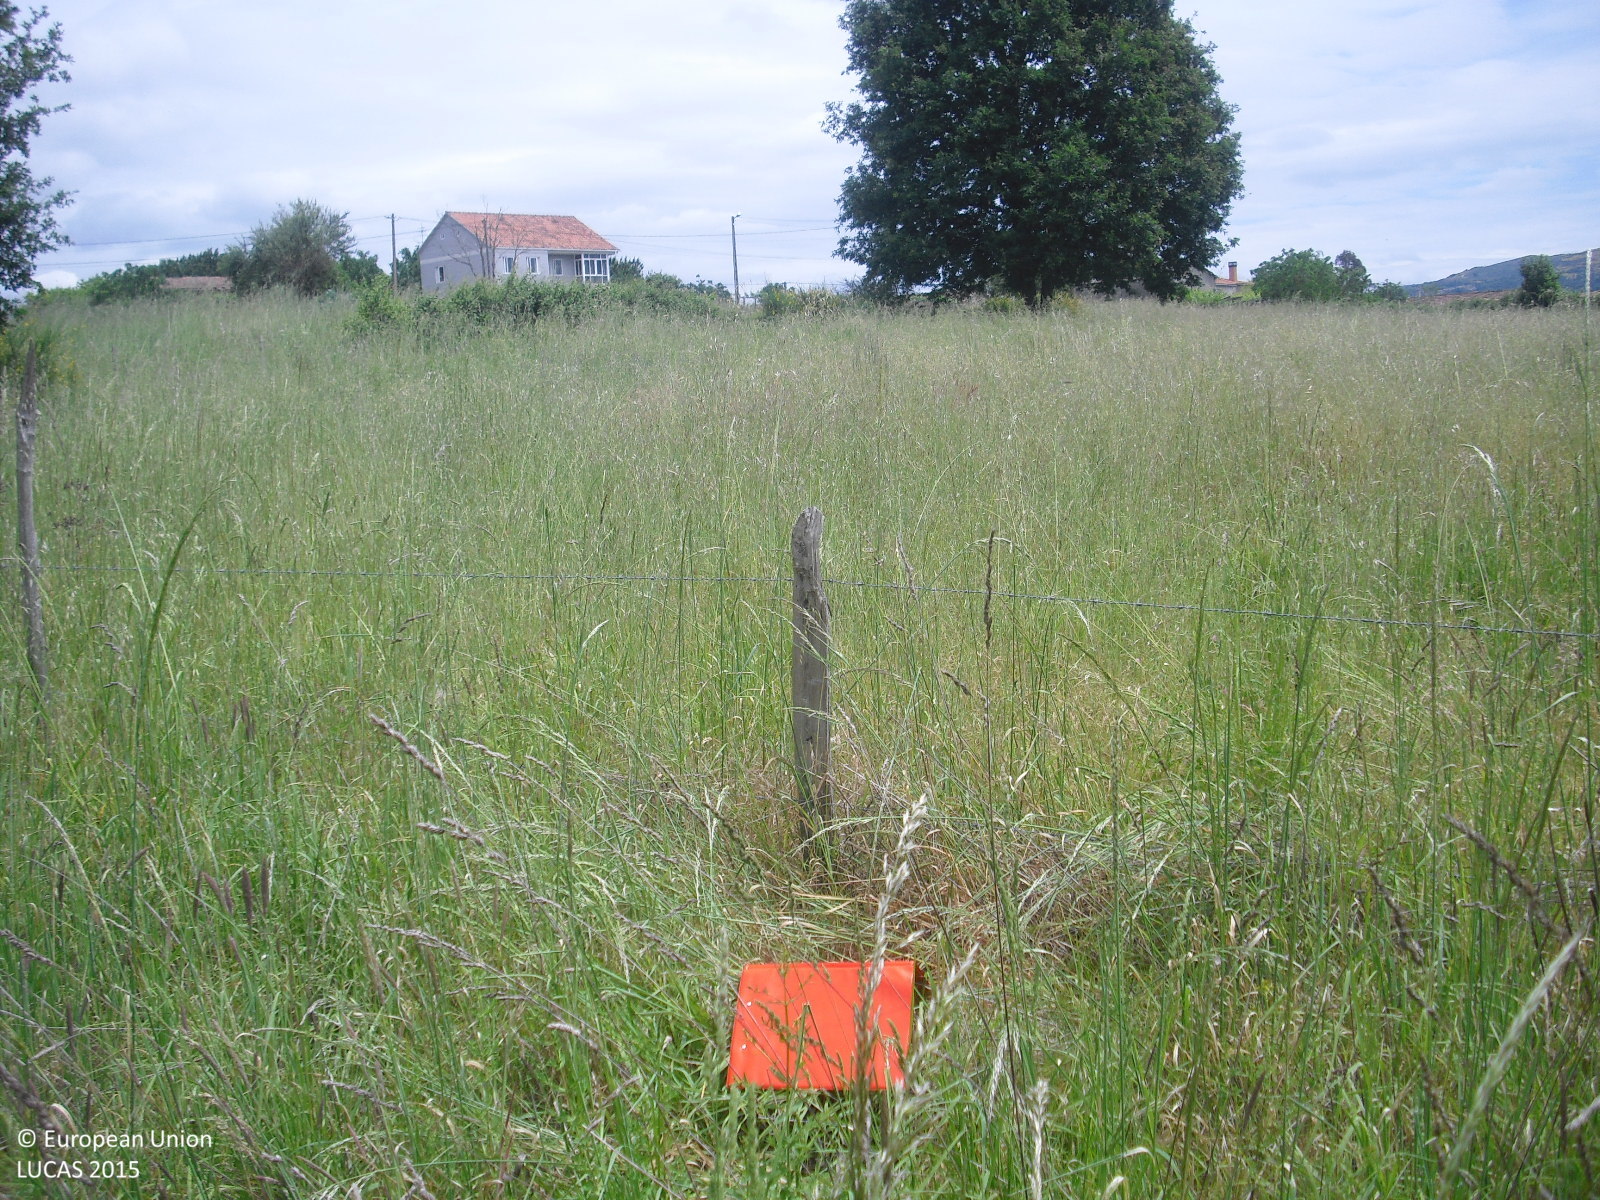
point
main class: Grassland
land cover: Grassland without tree/shrub cover
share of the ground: > 75 %
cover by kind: herbaceous plants 100 %
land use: Agriculture (excluding fallow land and kitchen gardens)
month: May
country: ES
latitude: 42.1643
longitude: -7.9299
